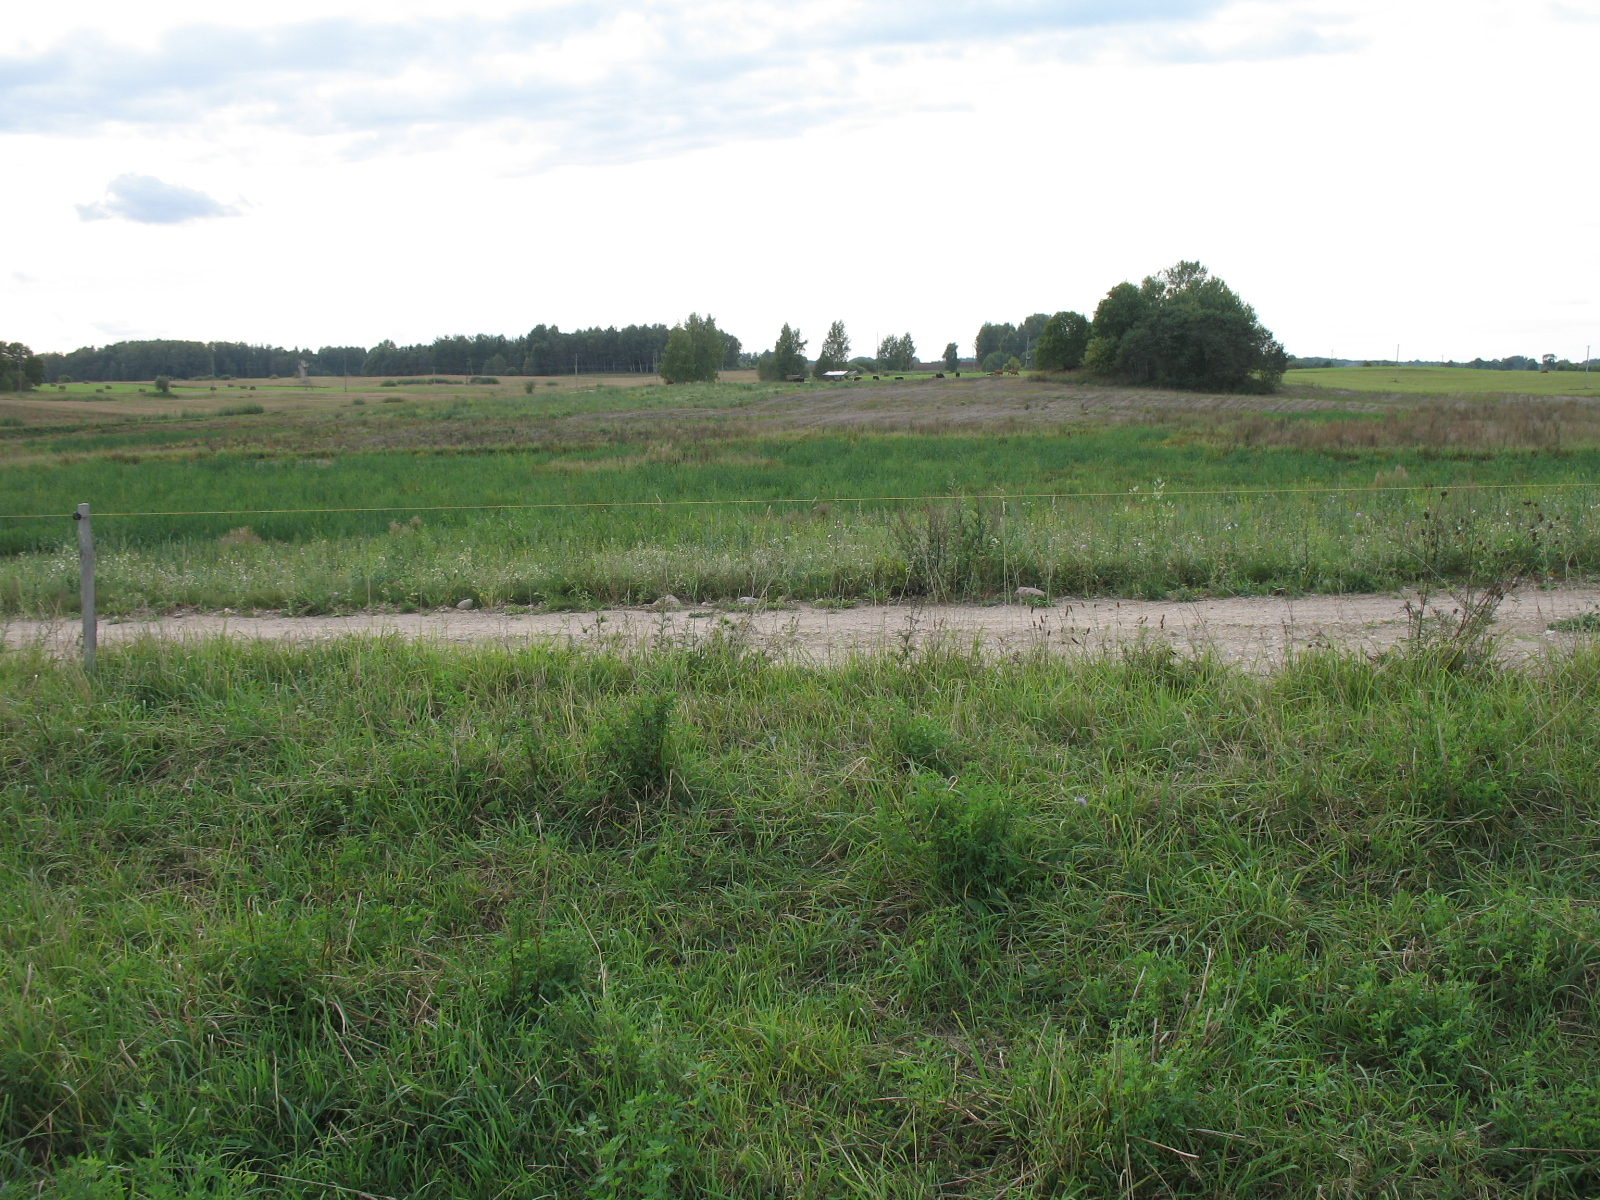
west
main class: Grassland
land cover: Grassland without tree/shrub cover
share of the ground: > 75 %
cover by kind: herbaceous plants 95 %, unconsolidated bare surface 5 %
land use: Agriculture (excluding fallow land and kitchen gardens)
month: September
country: LV
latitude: 56.0928
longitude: 25.9998
